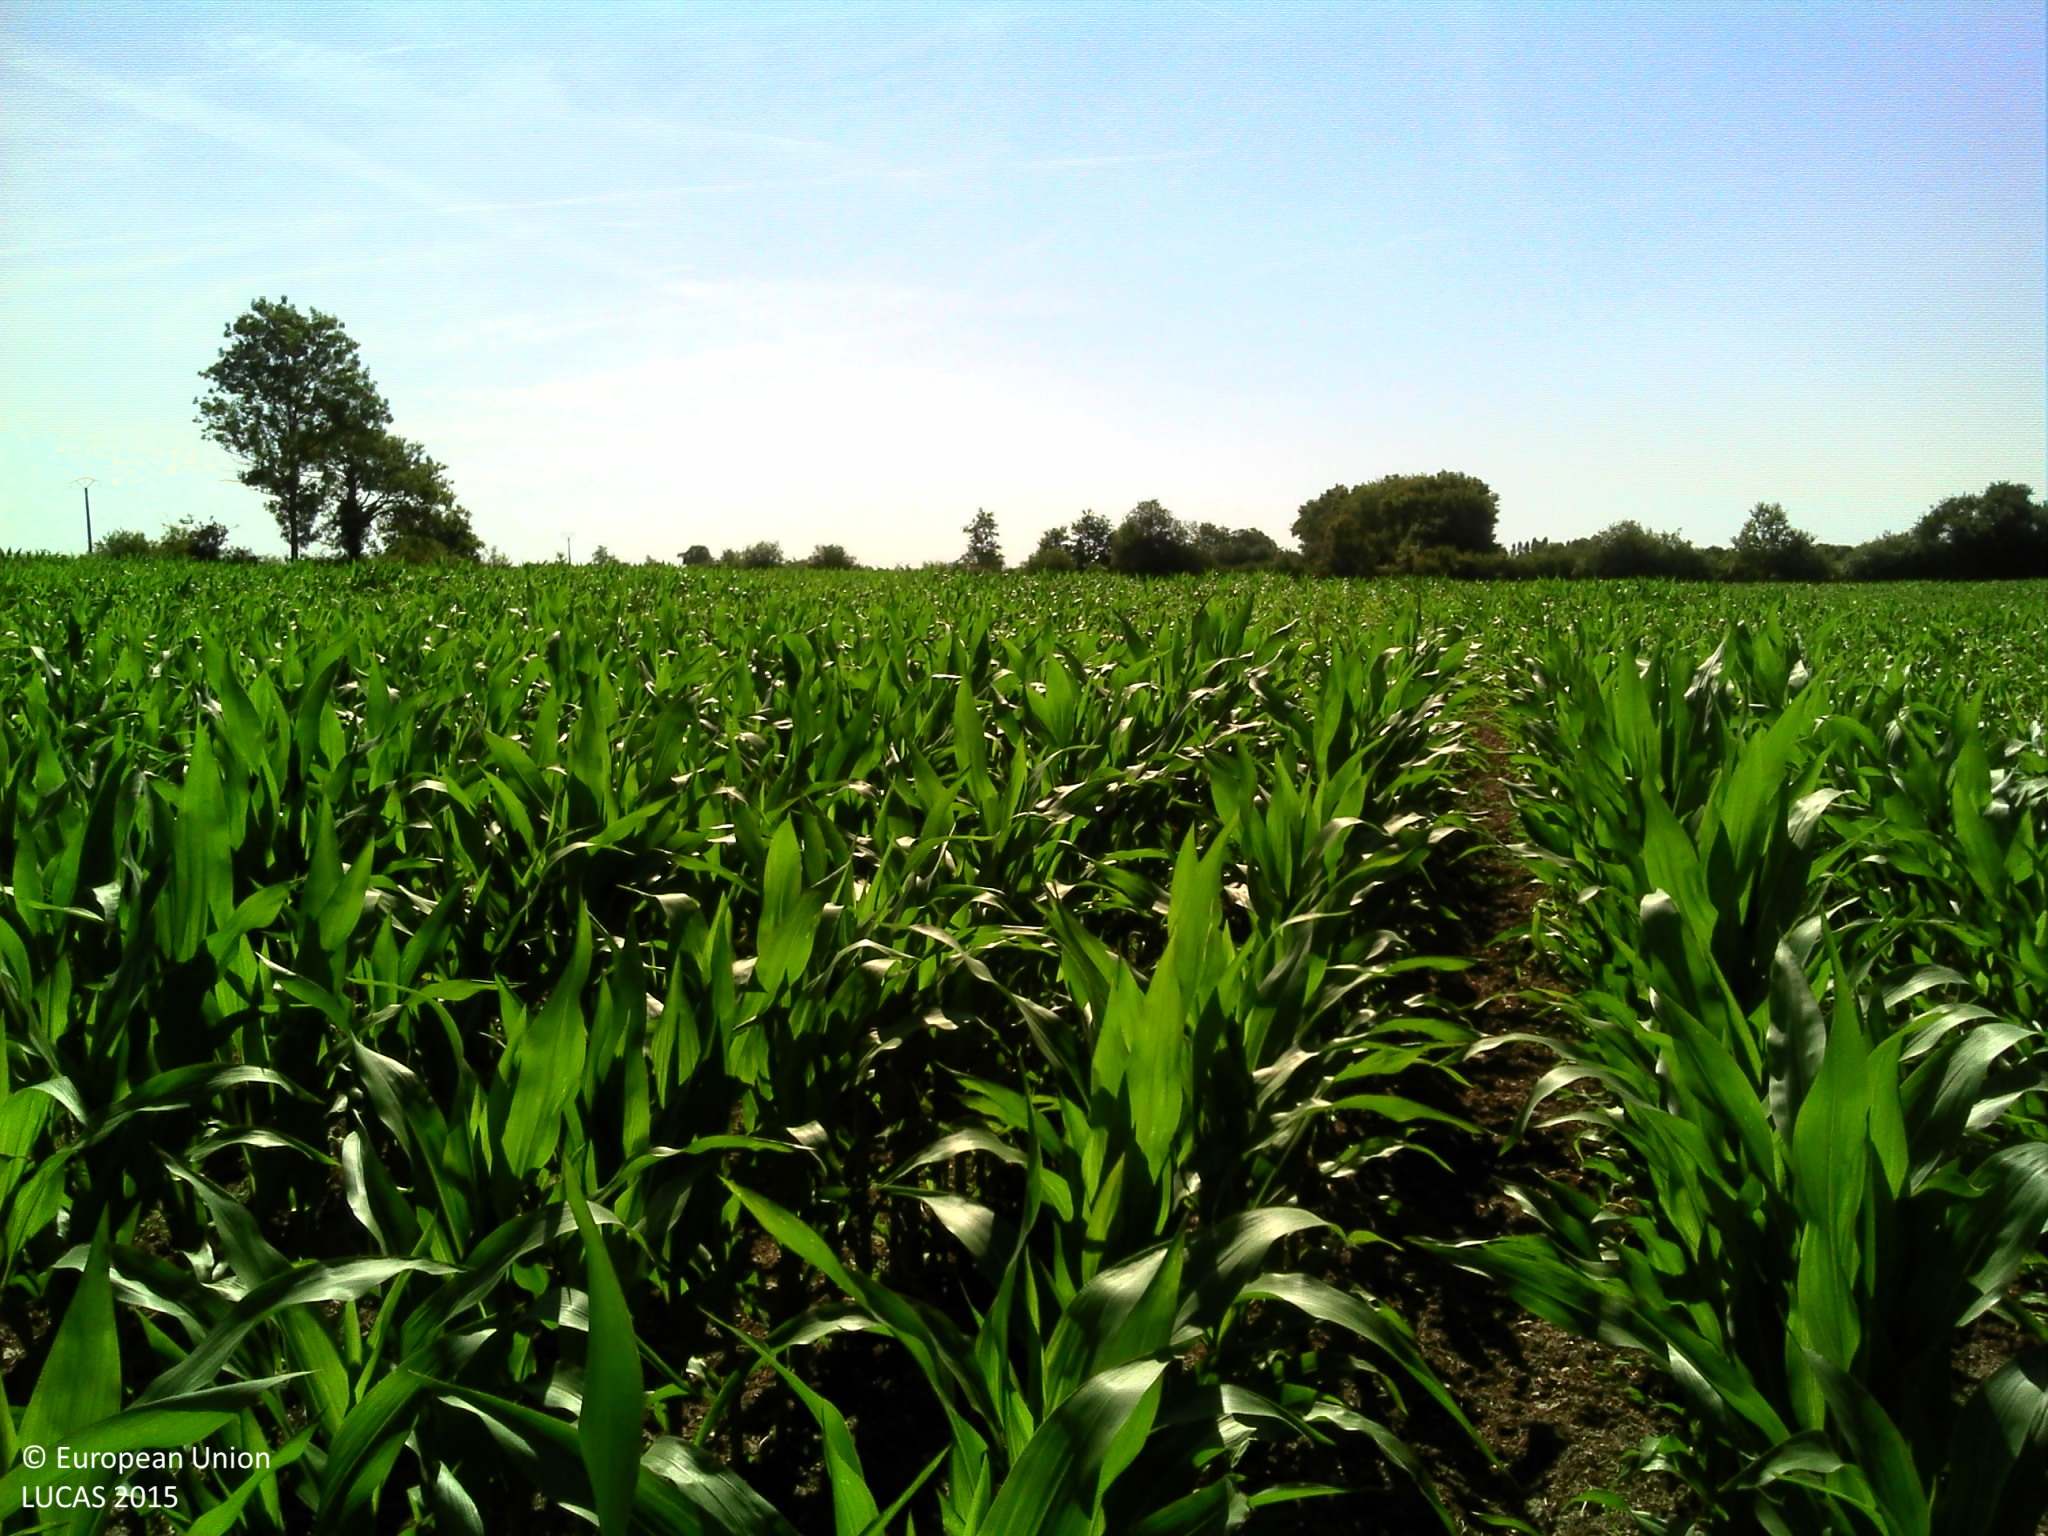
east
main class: Cropland
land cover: Maize
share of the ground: > 75 %
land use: Agriculture (excluding fallow land and kitchen gardens)
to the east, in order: Maize; Inland fresh water bodies; Single bushes/trees; Common wheat; Abandoned hedges; Fences; Ditches and canals; Grass margins; Paved roads, cycling and walking lanes; Grass margins; Ditches and canals; Abandoned hedges; Common wheat
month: June
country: FR
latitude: 46.9412
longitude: -1.7215
